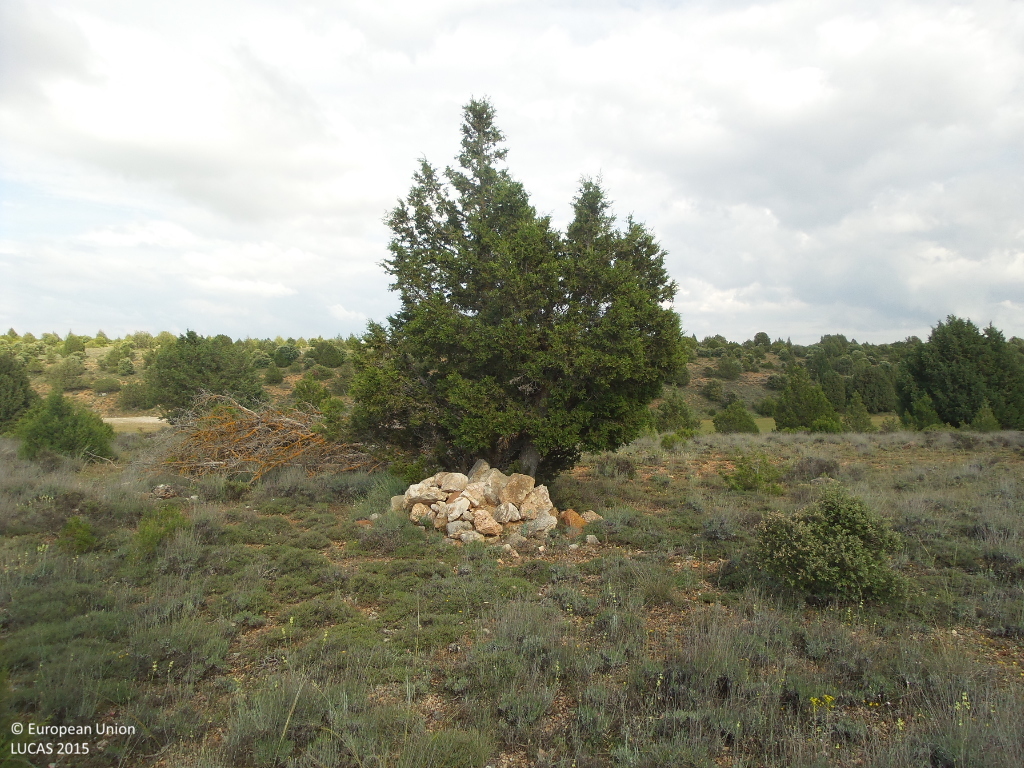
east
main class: Shrubland
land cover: Shrubland with sparse tree cover
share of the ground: 50 - 75 %
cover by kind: shrubs 75 %, herbaceous plants 10 %, unconsolidated bare surface 10 %, coniferous forest trees 5 %
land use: Semi-natural and natural areas not in use
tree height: < 5 m
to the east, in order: Shrubland with sparse tree cover; Lucerne; Shrubland with sparse tree cover; Tracks; Shrubland with sparse tree cover
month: June
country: ES
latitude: 41.3889
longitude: -3.1614
